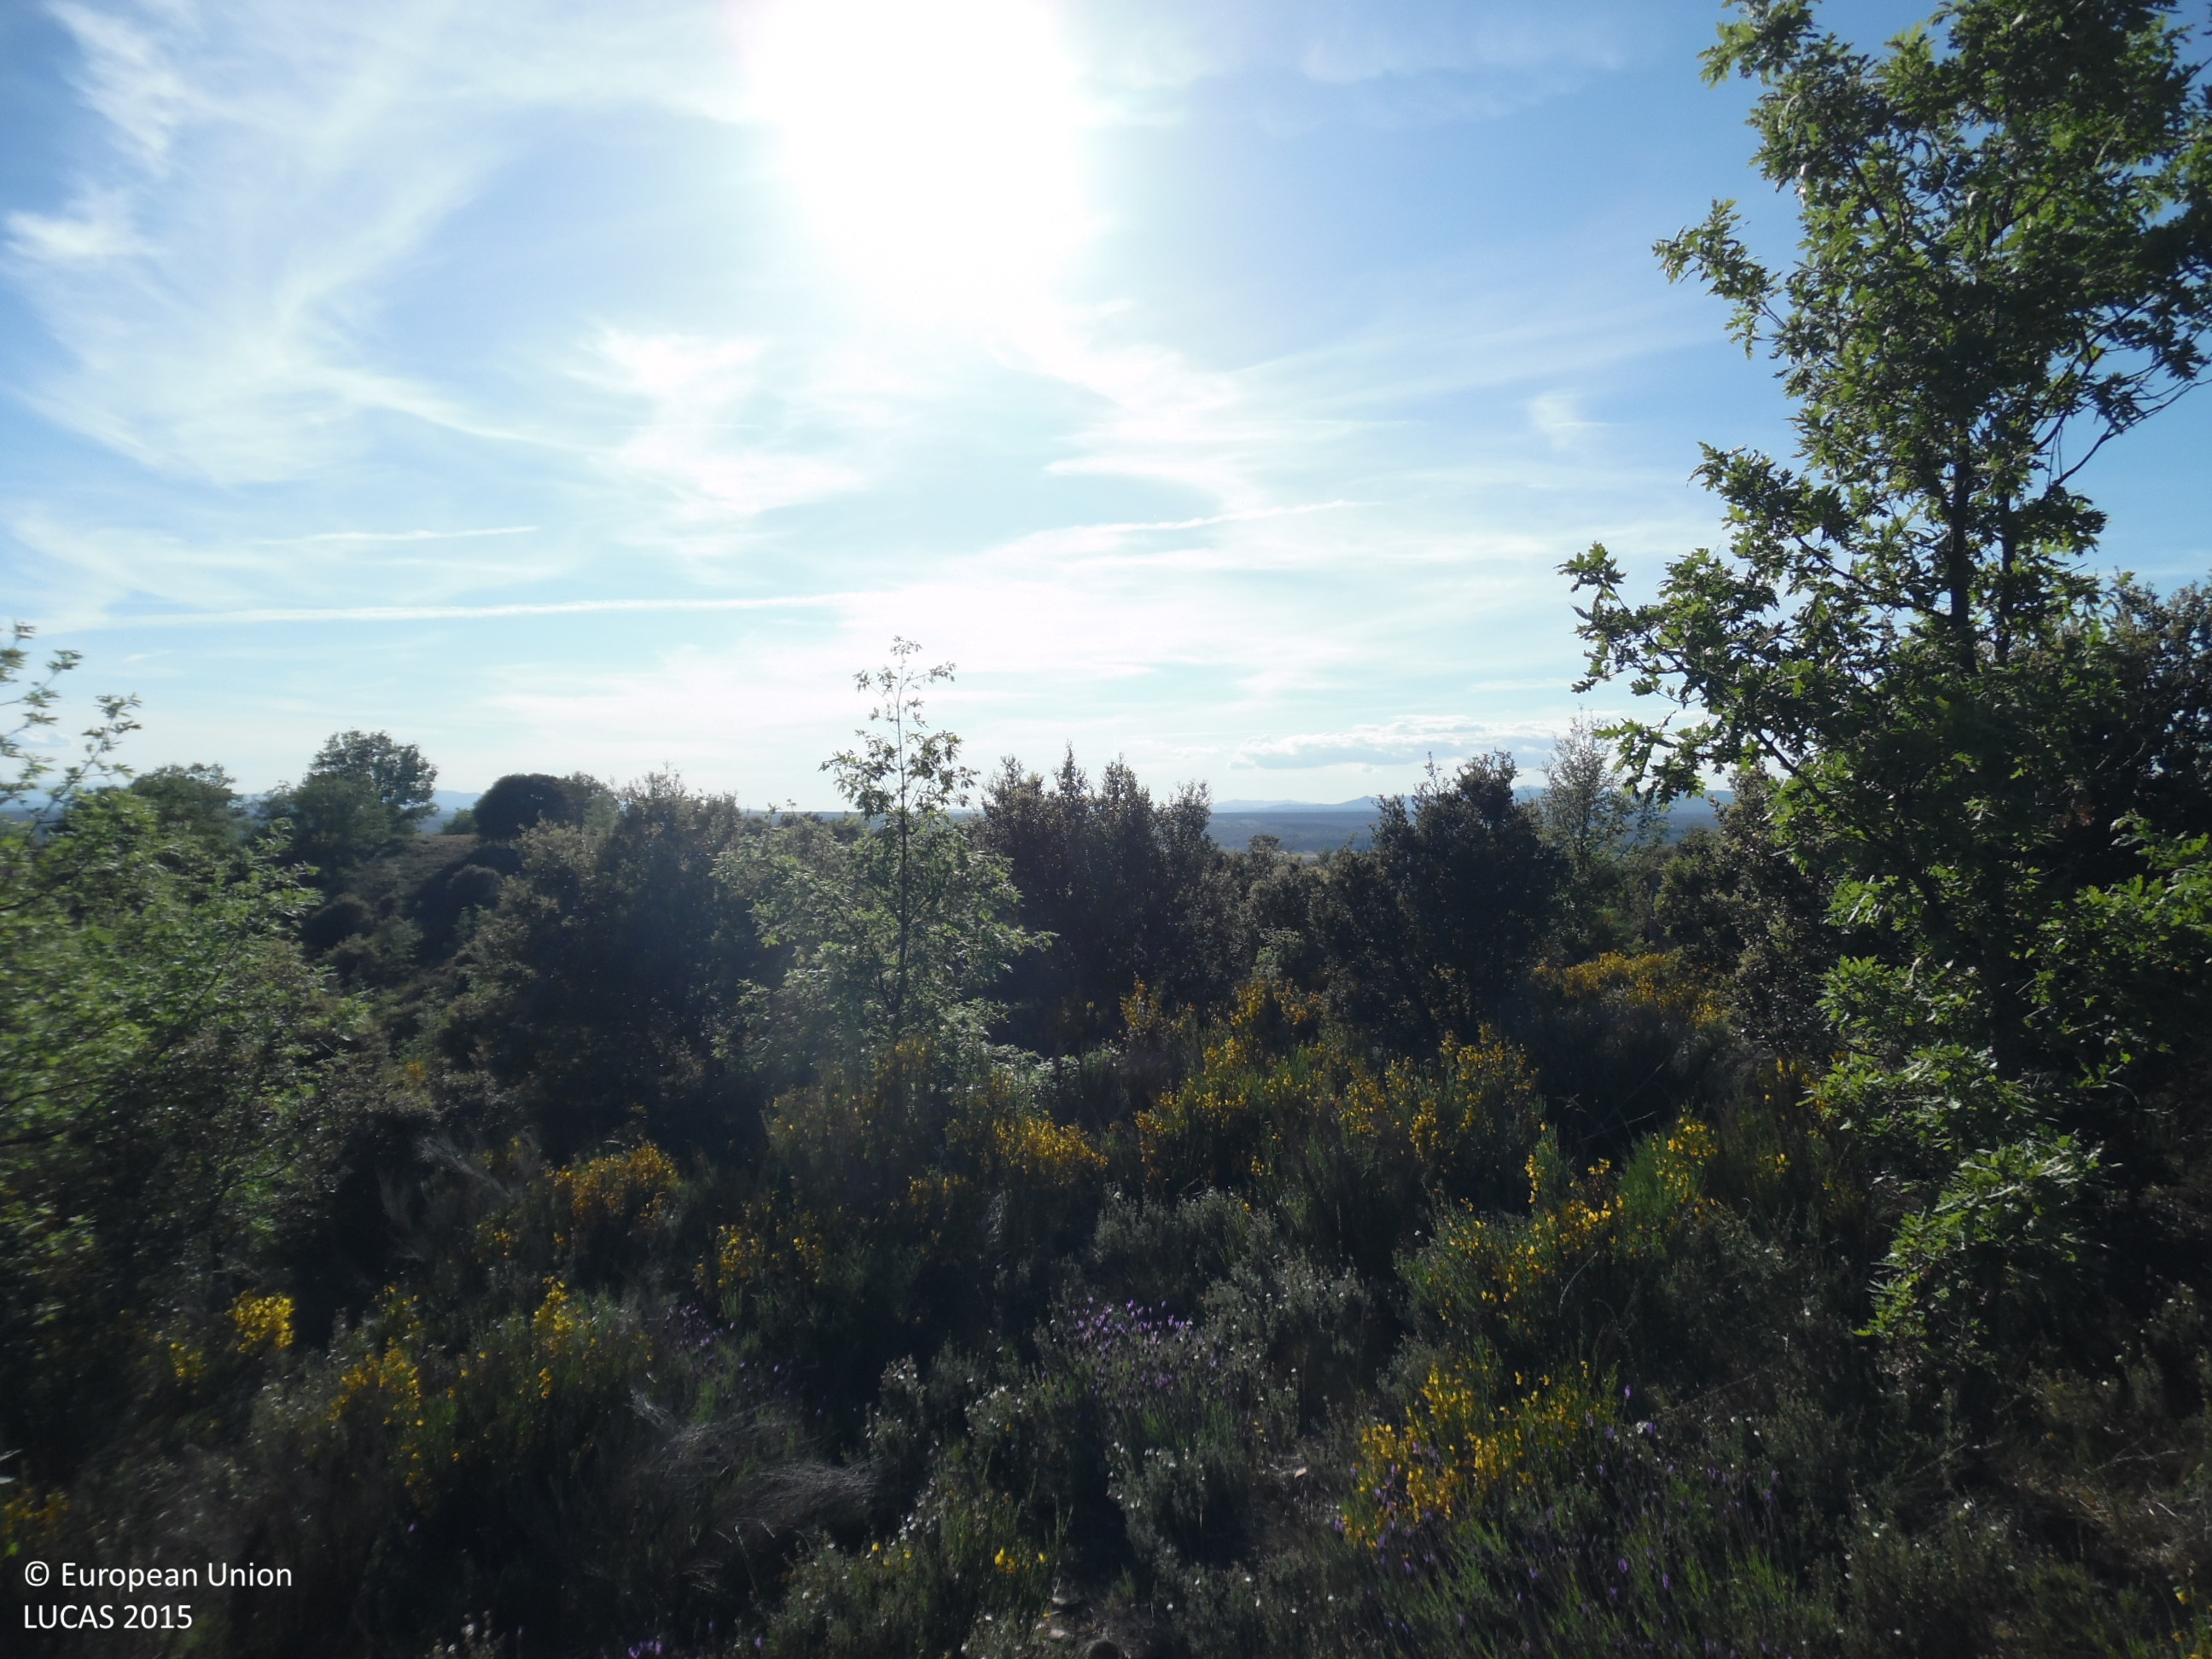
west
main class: Woodland
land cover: Broadleaved woodland
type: acidophilous oak and oak-birch forest
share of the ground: > 75 %
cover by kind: broadleaved forest trees 70 %, shrubs 20 %, herbaceous plants 10 %
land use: Abandoned areas
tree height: < 5 m
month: May
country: ES
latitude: 42.6180
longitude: -5.7925
